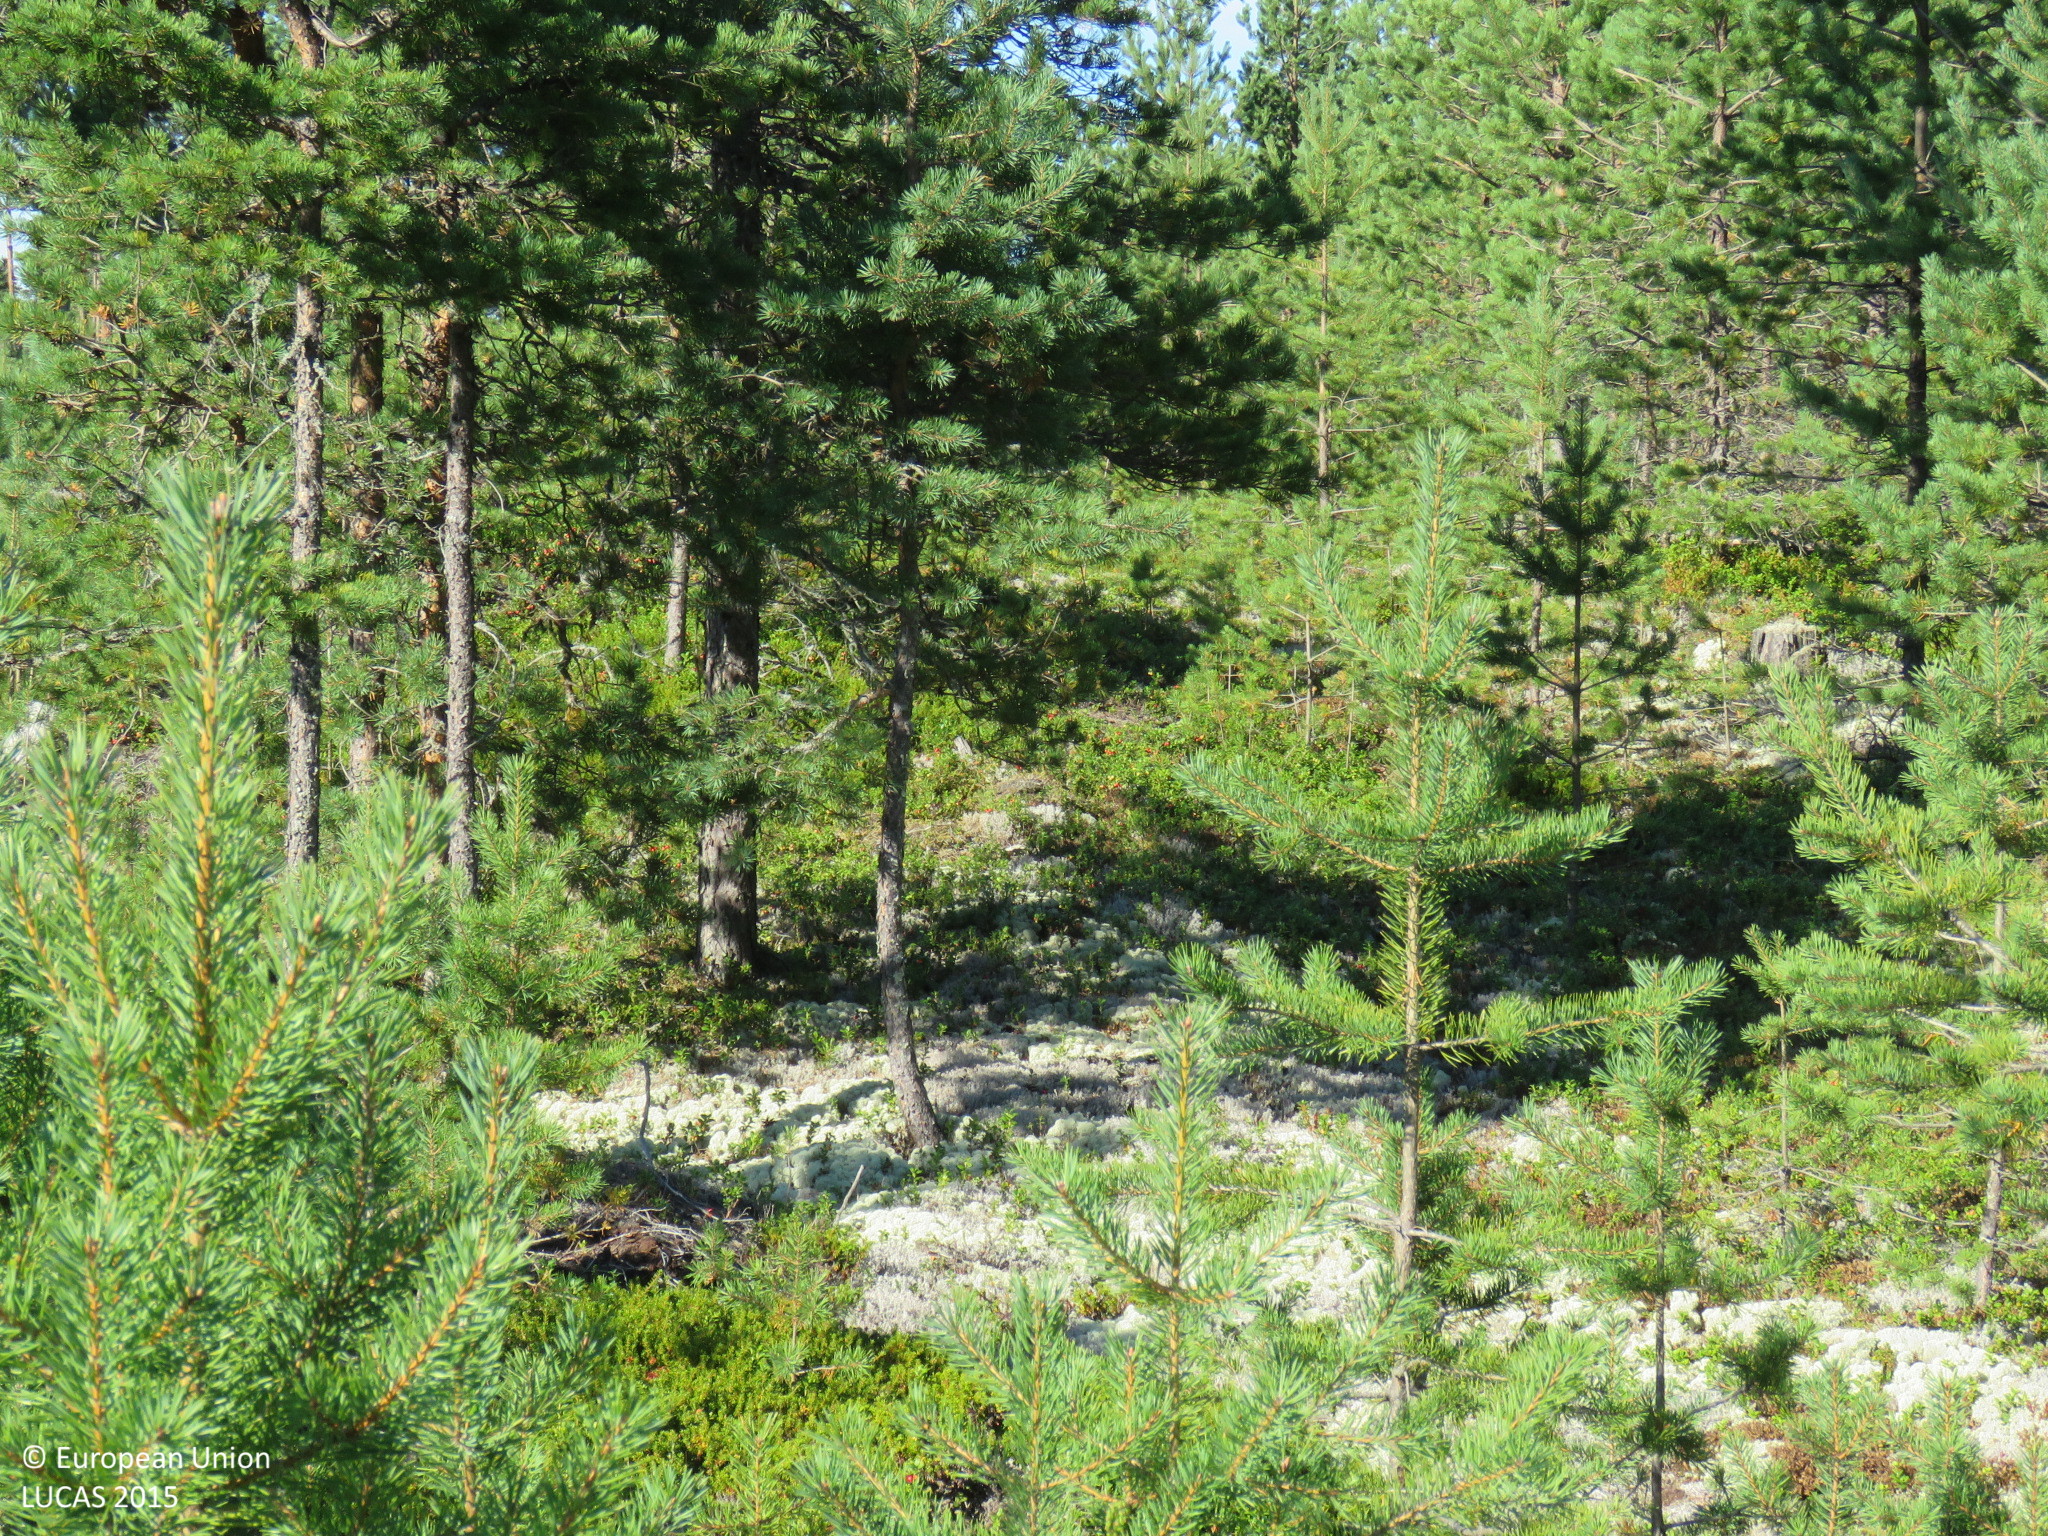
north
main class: Woodland
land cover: Pine dominated coniferous woodland
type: boreal forest
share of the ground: > 75 %
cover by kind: coniferous forest trees 80 %, shrubs 10 %, lichens and mosses 10 %
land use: Forestry
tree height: > 5 m
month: August
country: FI
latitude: 65.0607
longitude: 24.8413
